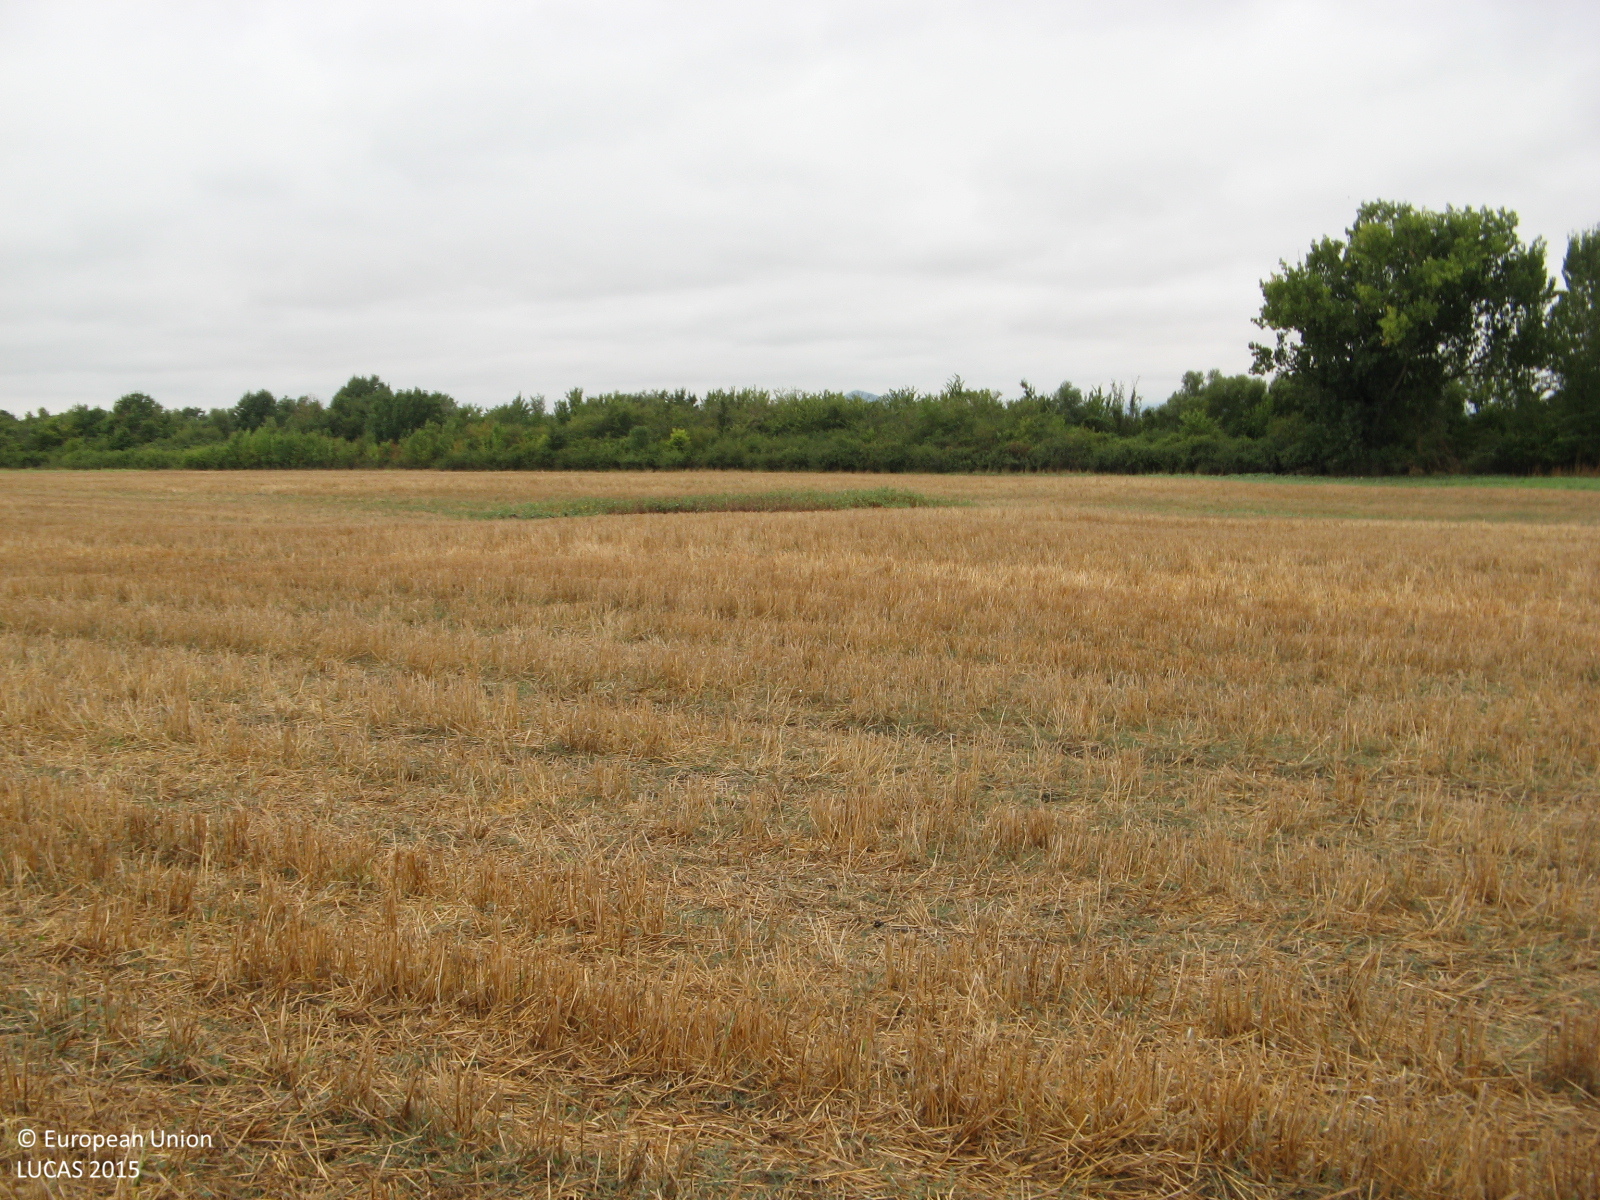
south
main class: Cropland
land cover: Common wheat
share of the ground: > 75 %
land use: Agriculture (excluding fallow land and kitchen gardens)
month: August
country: BG
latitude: 43.3460
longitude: 25.2355
